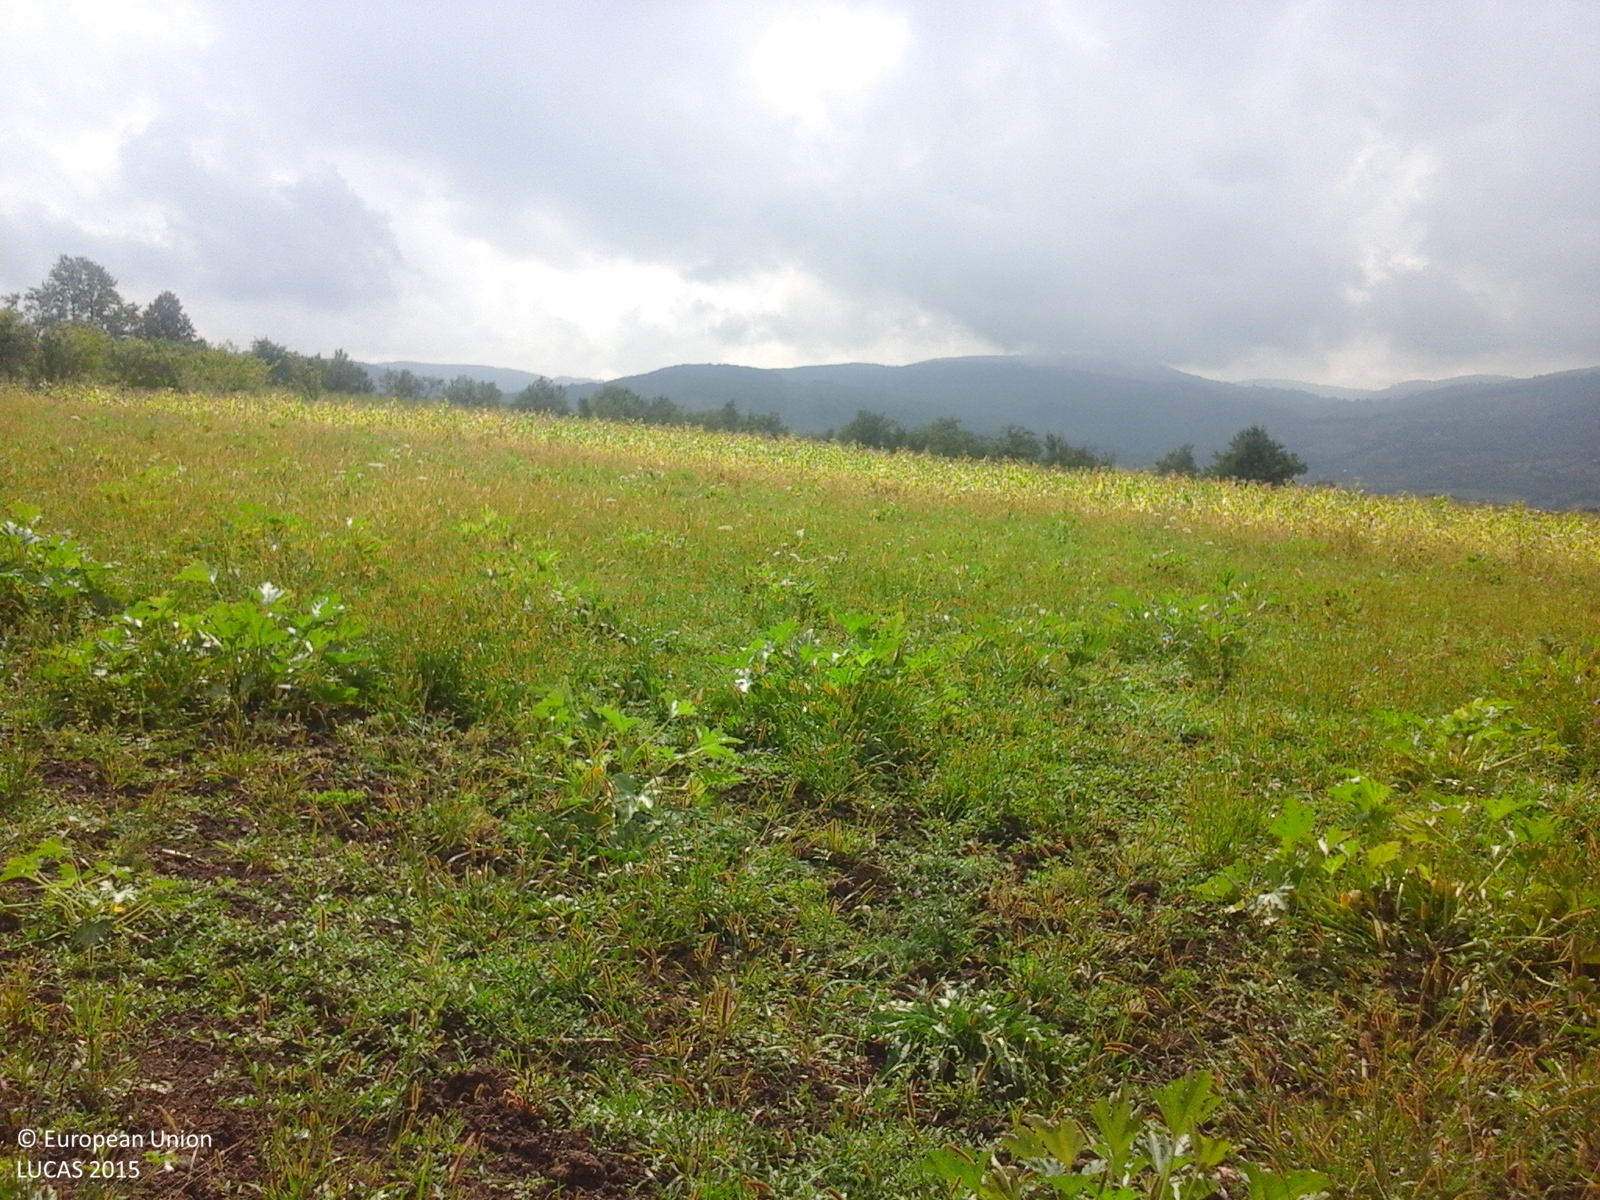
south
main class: Grassland
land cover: Grassland without tree/shrub cover
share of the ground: > 75 %
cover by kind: herbaceous plants 100 %
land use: Agriculture (excluding fallow land and kitchen gardens)
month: September
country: RO
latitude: 46.9565
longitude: 22.5514
